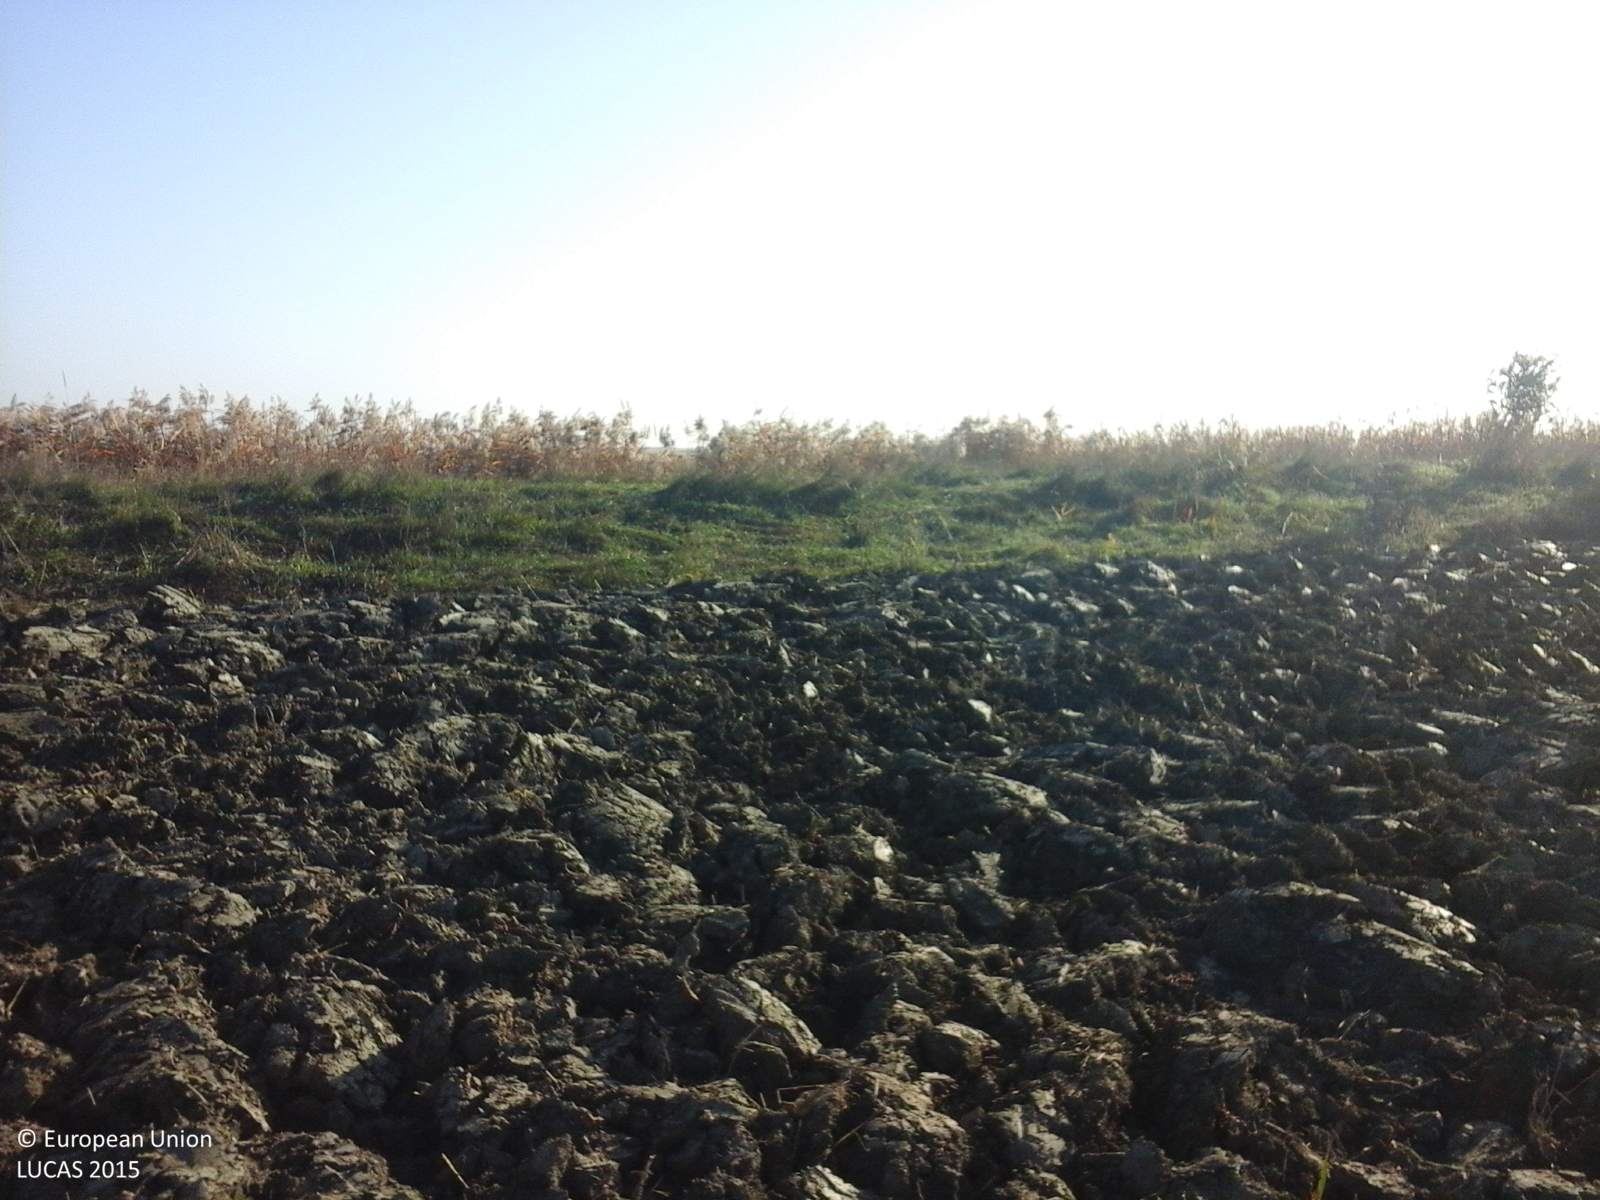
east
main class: Cropland
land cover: Maize
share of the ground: < 10 %
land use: Agriculture (excluding fallow land and kitchen gardens)
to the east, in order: Maize; Grassland without tree/shrub cover; Ditches and canals; Tracks; Grass margins; Other bare soil
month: October
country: RO
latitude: 45.0441
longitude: 26.5897
